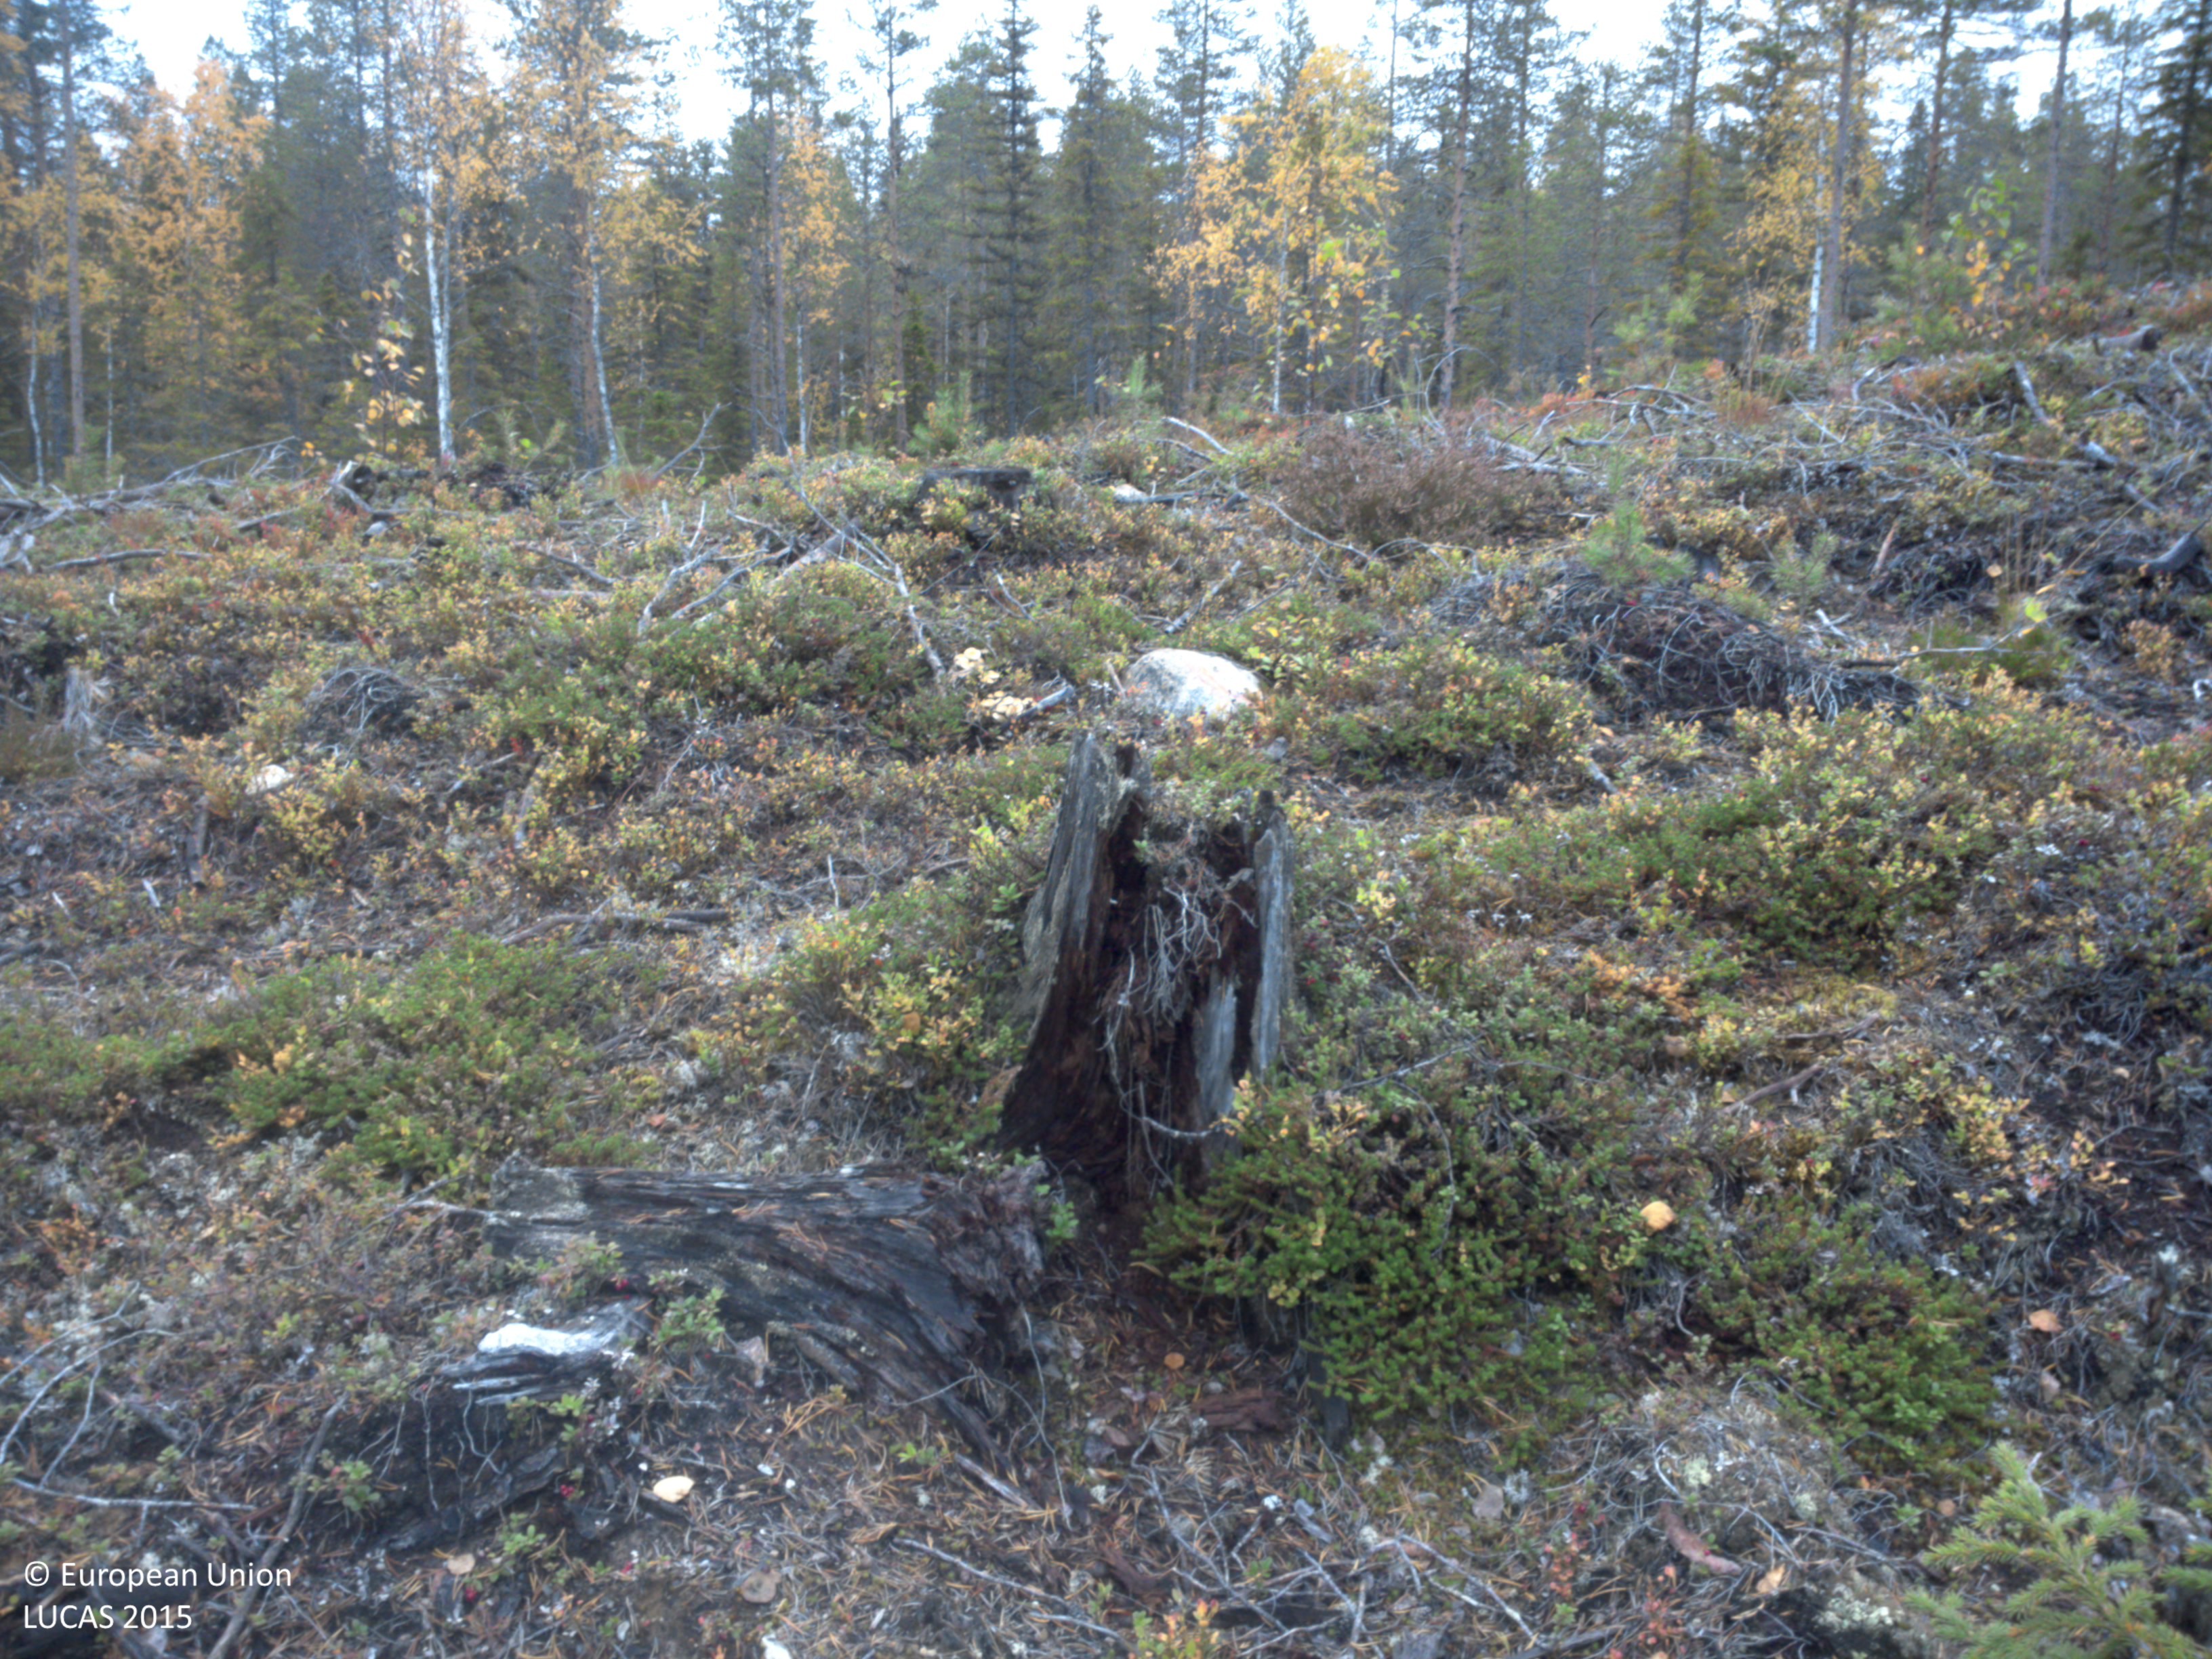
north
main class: Shrubland
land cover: Shrubland with sparse tree cover
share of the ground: > 75 %
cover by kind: shrubs 95 %, coniferous forest trees 5 %
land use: Forestry
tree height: < 5 m
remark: Clear cut
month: September
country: SE
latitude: 64.7670
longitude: 19.8309
